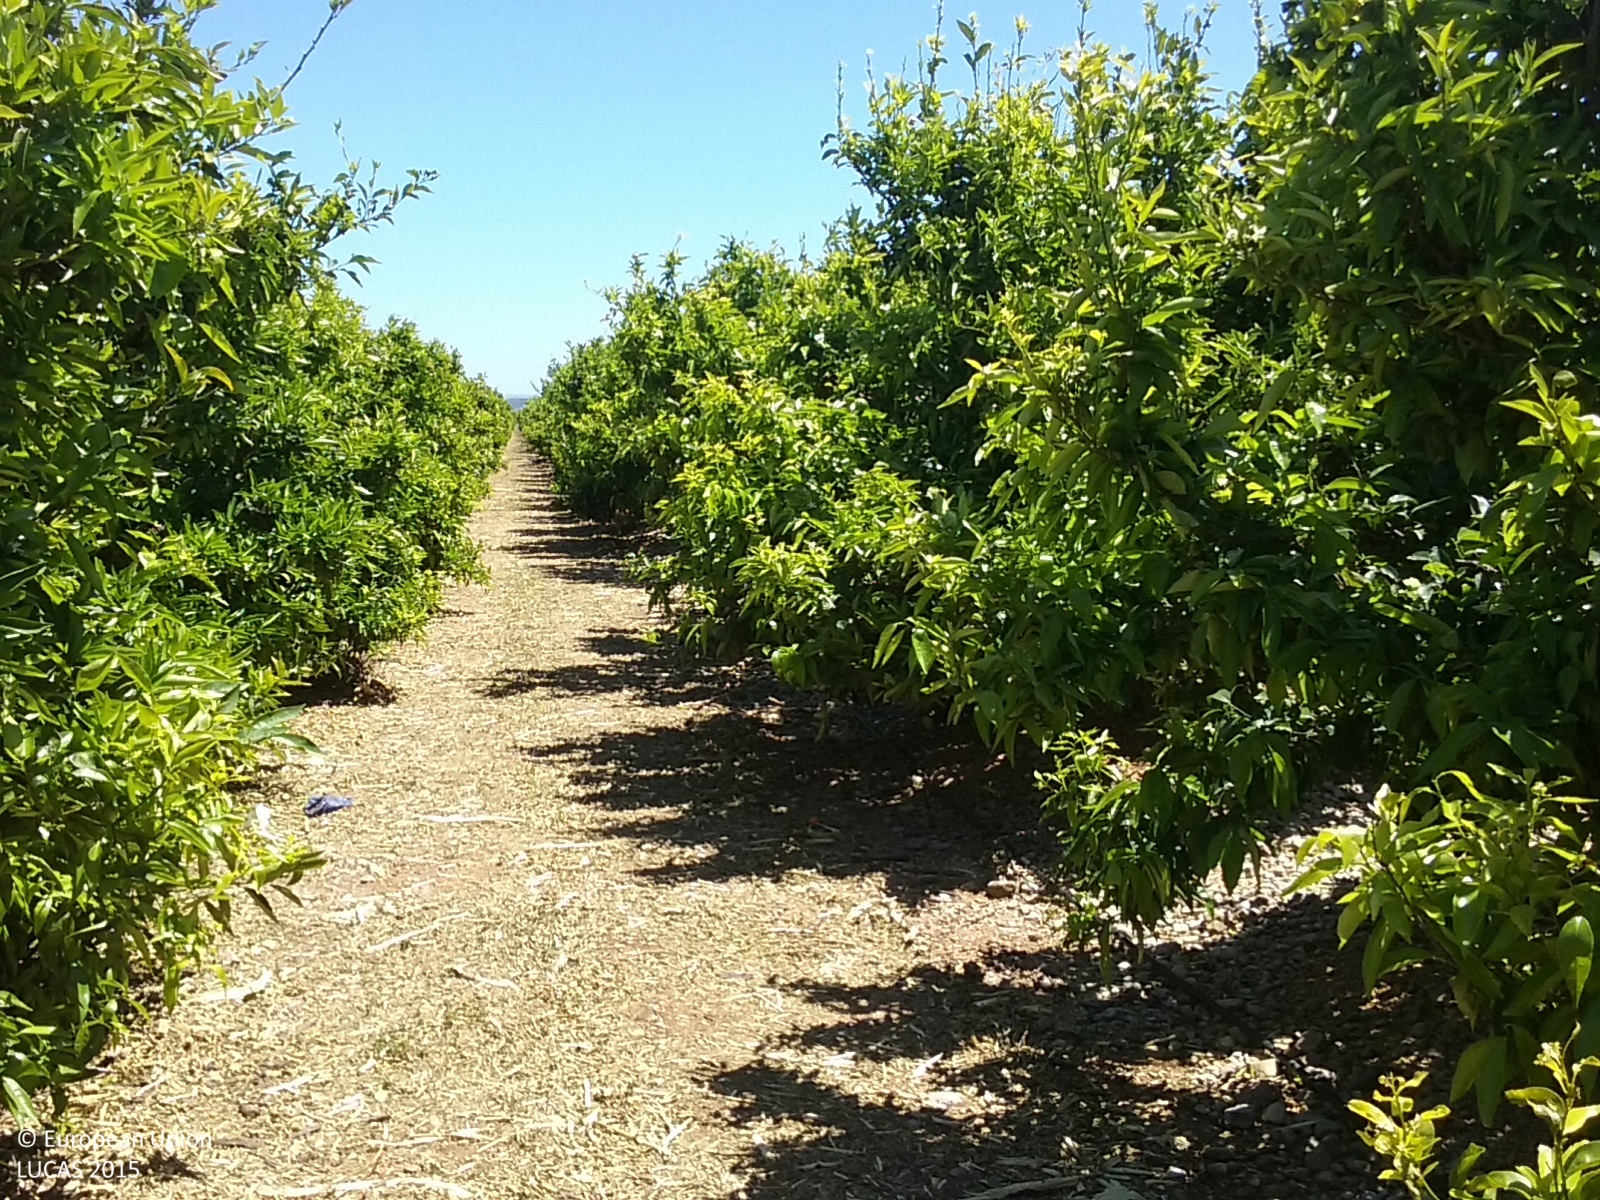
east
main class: Cropland
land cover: Oranges
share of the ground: 50 - 75 %
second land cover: Other bare soil
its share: > 75 %
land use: Agriculture (excluding fallow land and kitchen gardens)
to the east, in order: Oranges; Other bare soil; Tracks
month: May
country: ES
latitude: 40.7278
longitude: 0.4394
